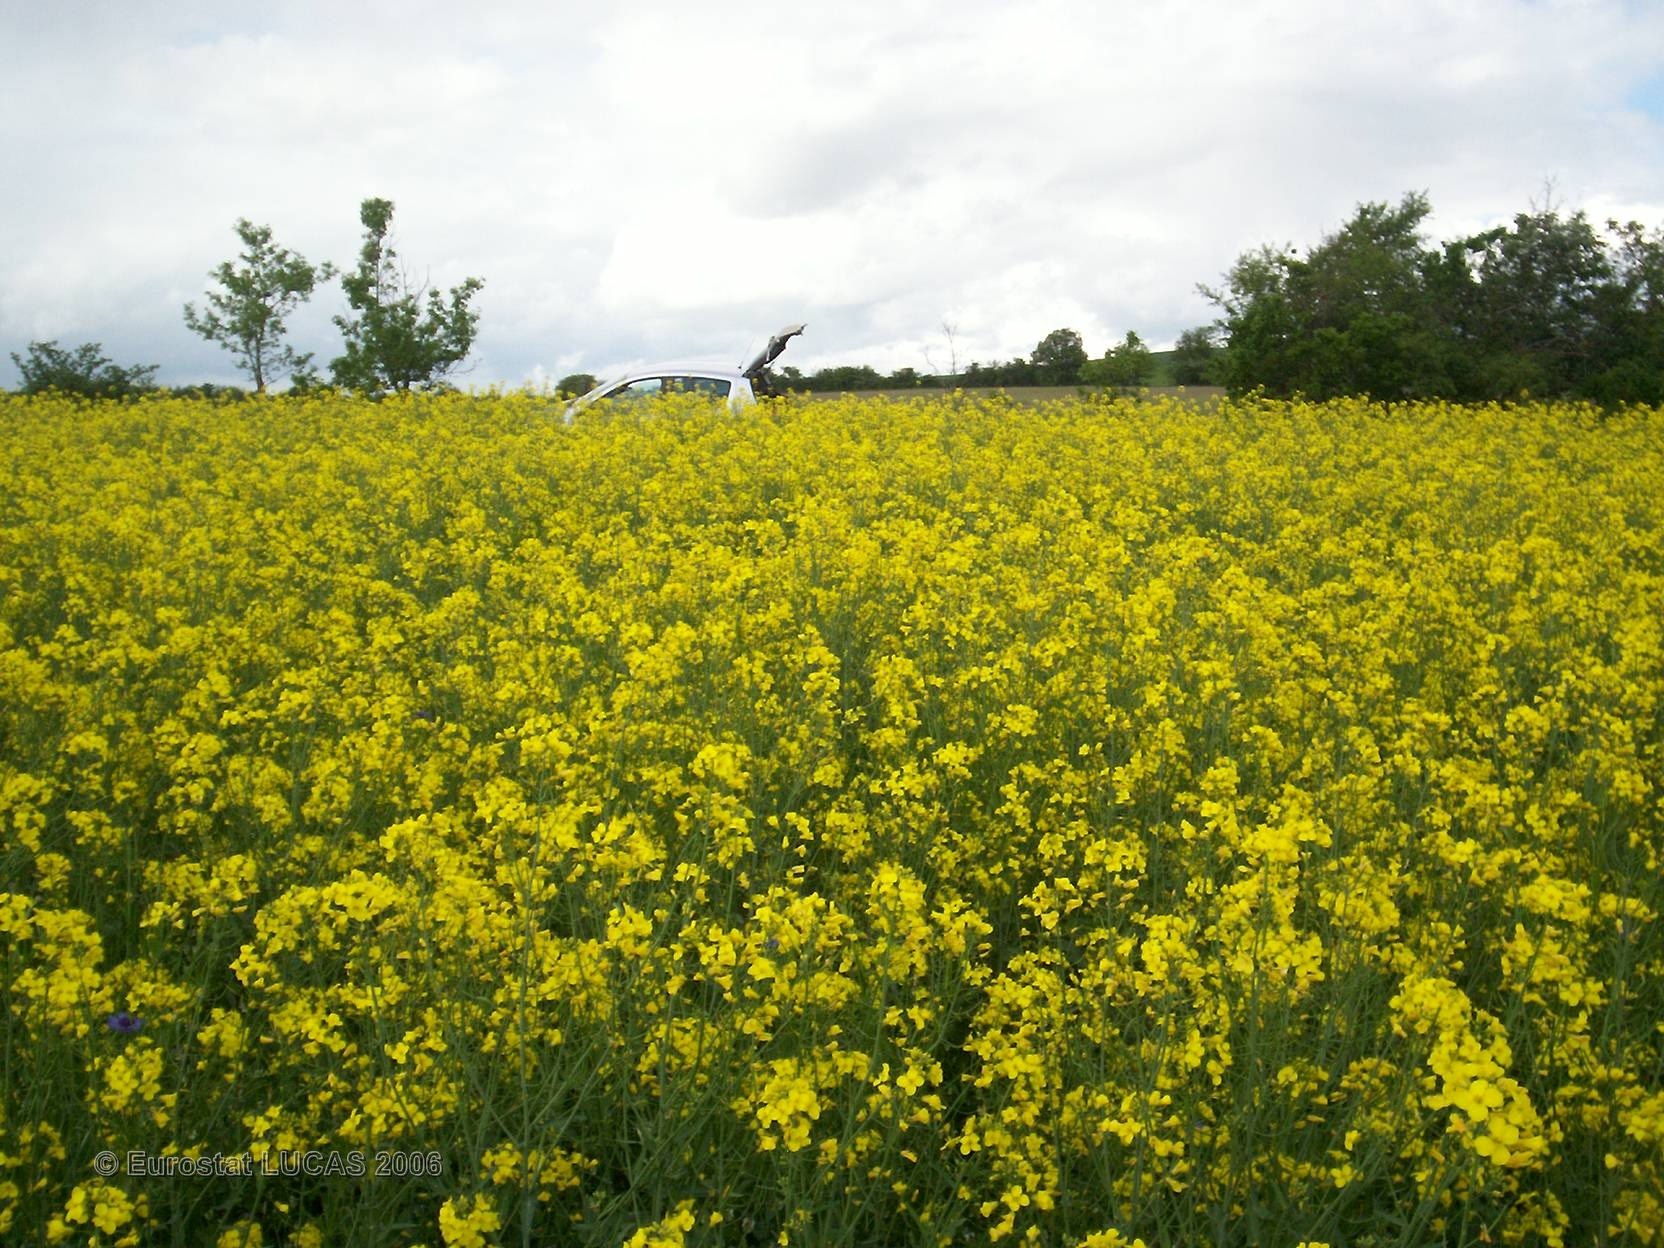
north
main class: Cropland
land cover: Rape and turnip rape
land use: Agriculture (excluding fallow land and kitchen gardens)
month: May
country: FR
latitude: 46.9933
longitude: 4.6486
